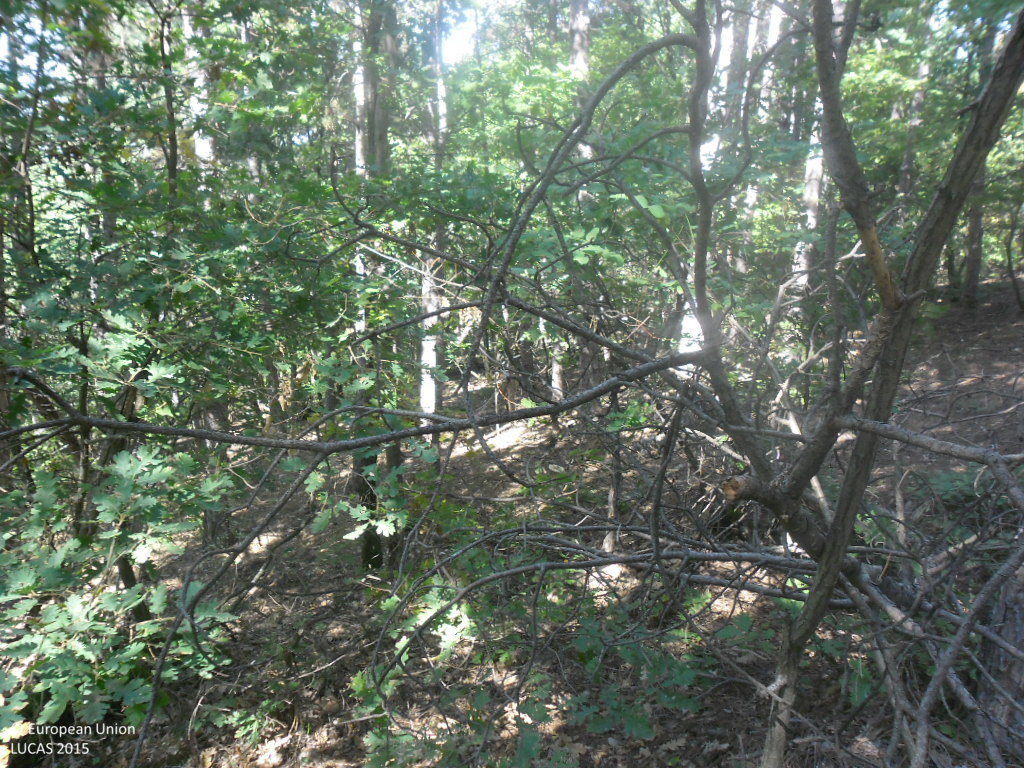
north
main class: Woodland
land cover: Pine dominated mixed woodland
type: hemiboreal forest and nemoral coniferous forest and mixed broadleaved-coniferous forest
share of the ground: > 75 %
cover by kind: coniferous forest trees 75 %, broadleaved forest trees 25 %
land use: Forestry
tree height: > 5 m
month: October
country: BG
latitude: 41.3941
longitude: 23.2594
